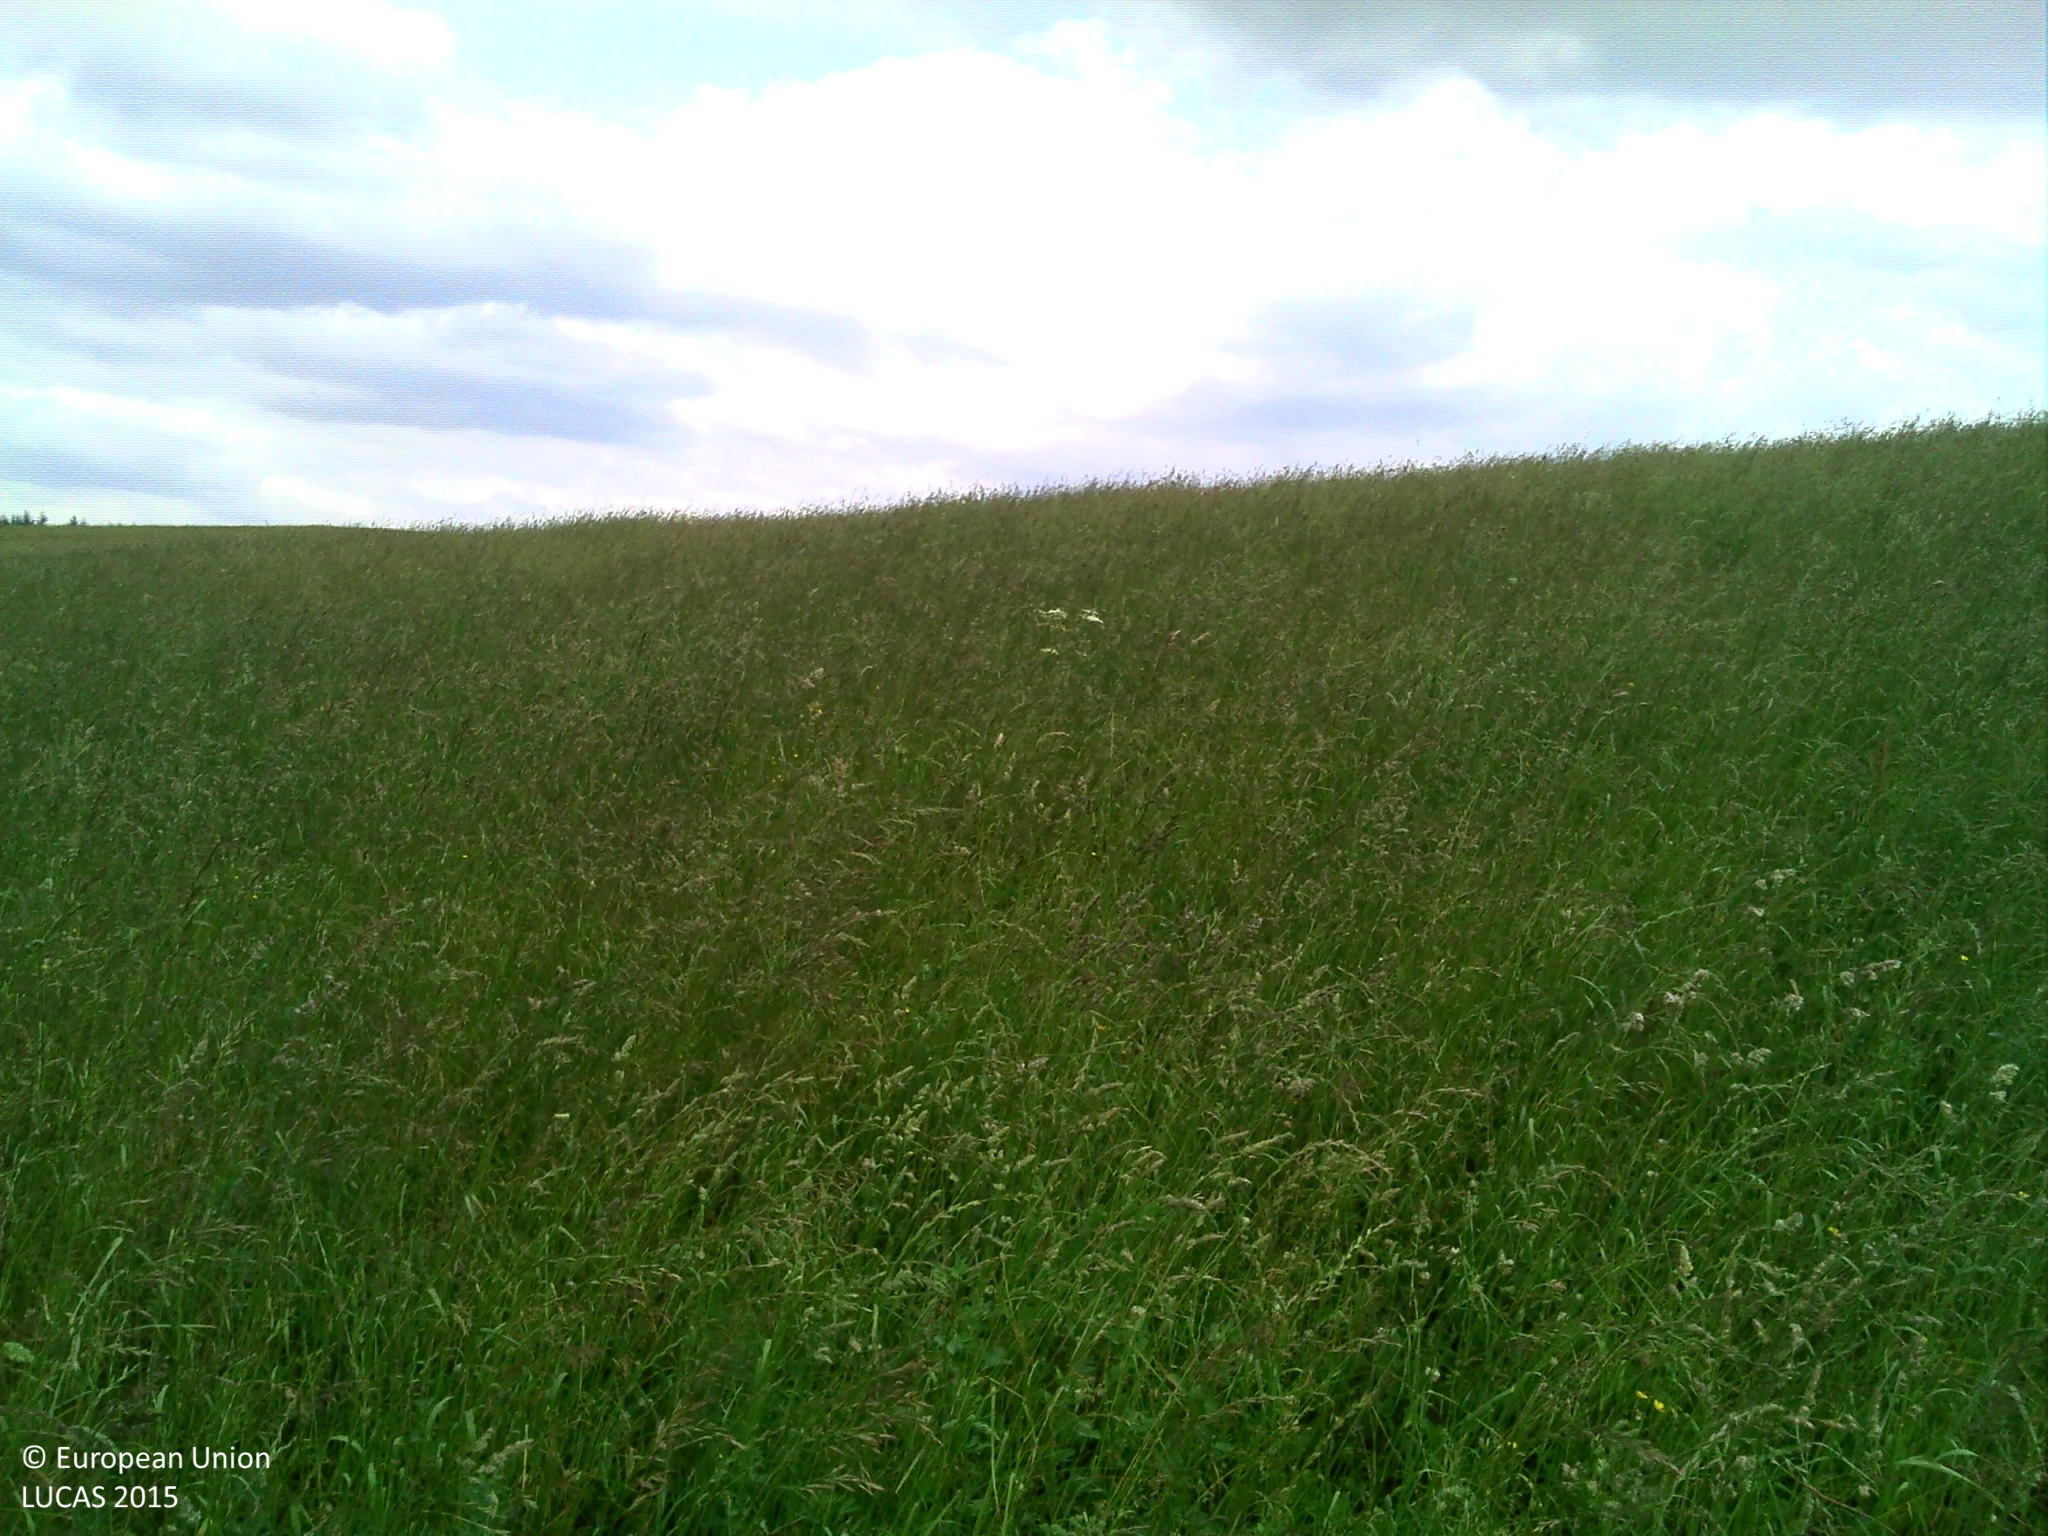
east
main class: Grassland
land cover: Grassland without tree/shrub cover
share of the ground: > 75 %
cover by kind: herbaceous plants 100 %
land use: Agriculture (excluding fallow land and kitchen gardens)
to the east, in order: Grassland without tree/shrub cover; Fences; Grassland without tree/shrub cover
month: June
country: FR
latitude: 47.4401
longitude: 3.8847
